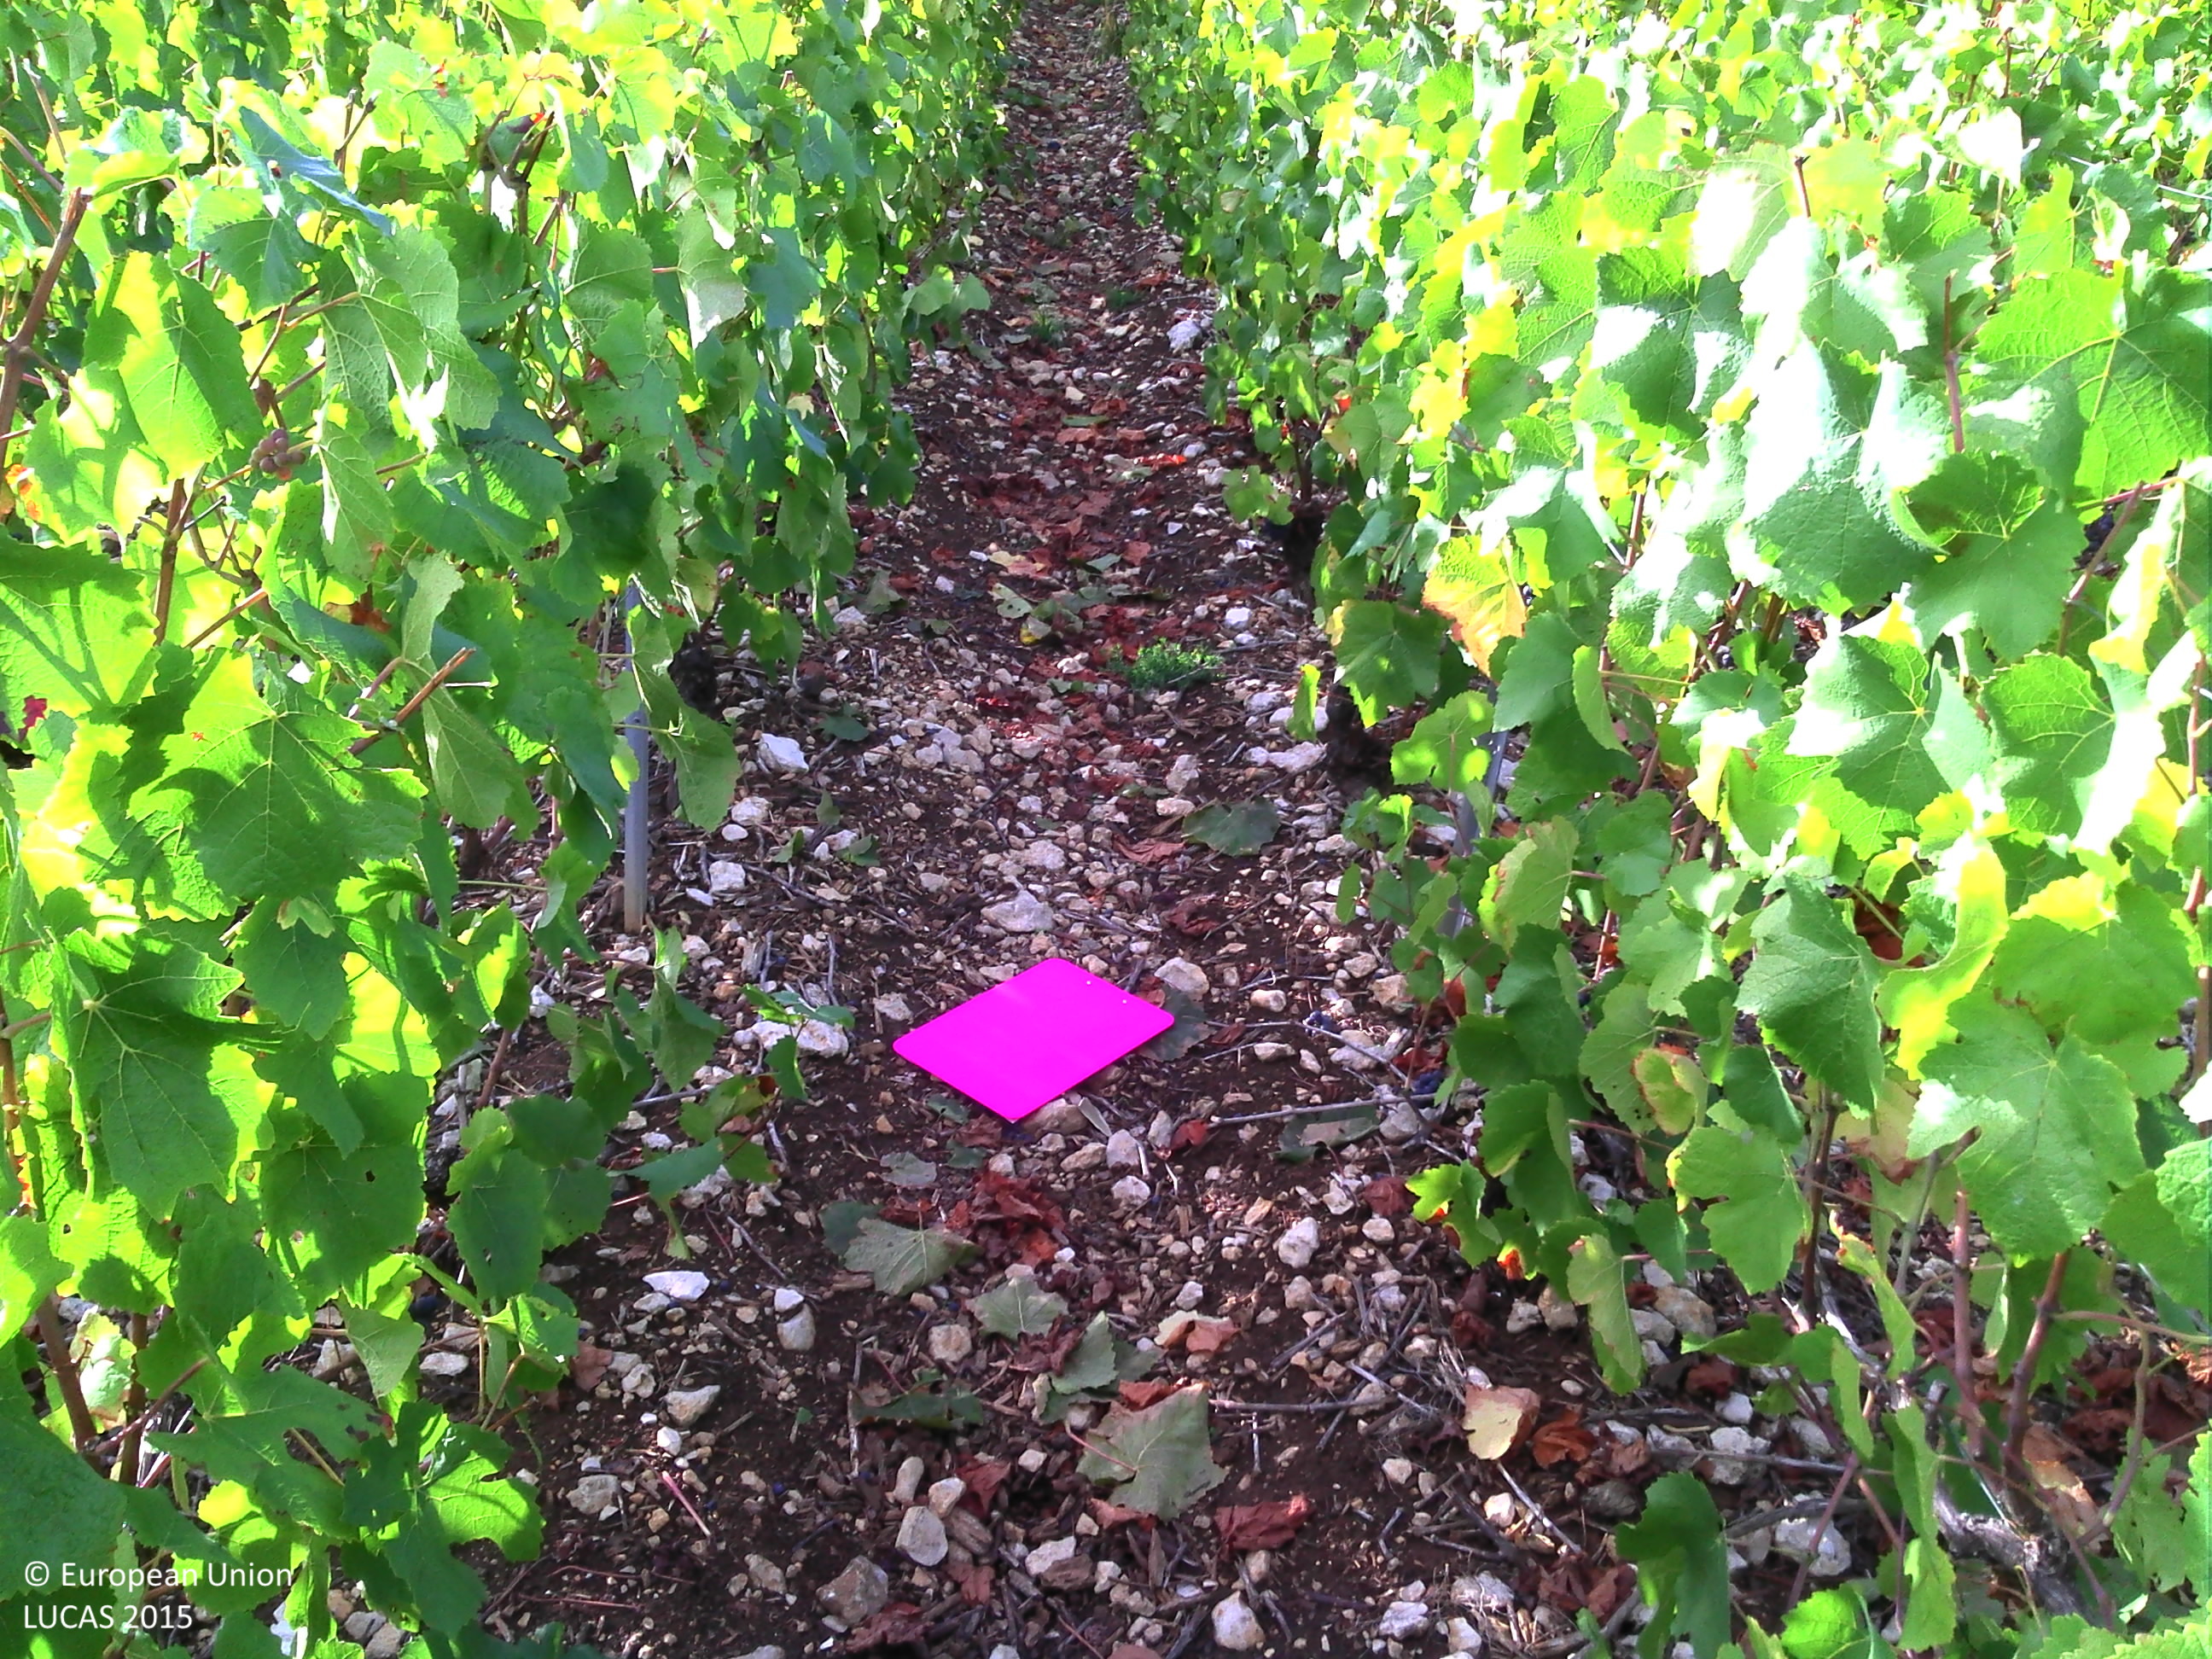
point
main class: Cropland
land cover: Vineyards
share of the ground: 25 - 50 %
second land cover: Other bare soil
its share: > 75 %
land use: Agriculture (excluding fallow land and kitchen gardens)
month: September
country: FR
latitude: 48.1868
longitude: 4.7119
